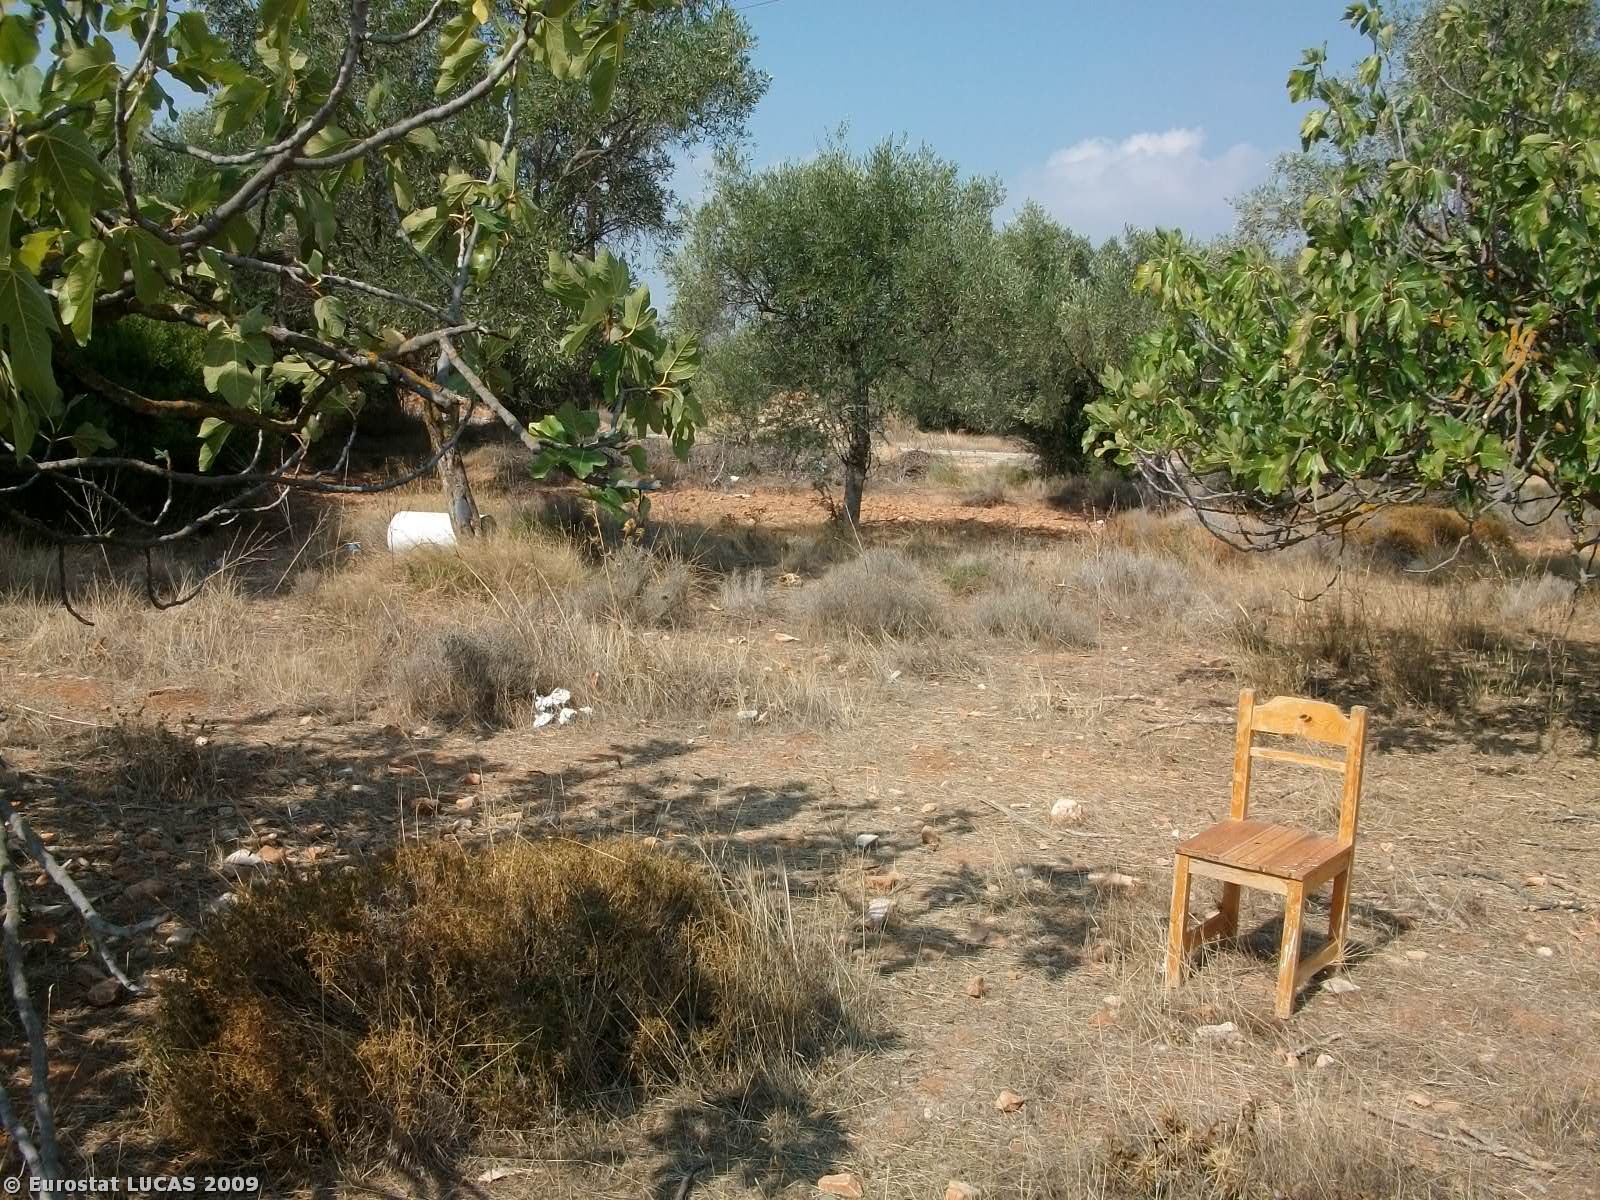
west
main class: Cropland
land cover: Olive groves
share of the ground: 10 - 25 %
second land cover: Grassland with sparse tree/shrub cover
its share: > 75 %
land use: Agriculture (excluding fallow land and kitchen gardens)
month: October
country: GR
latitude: 37.8805
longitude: 23.8855
